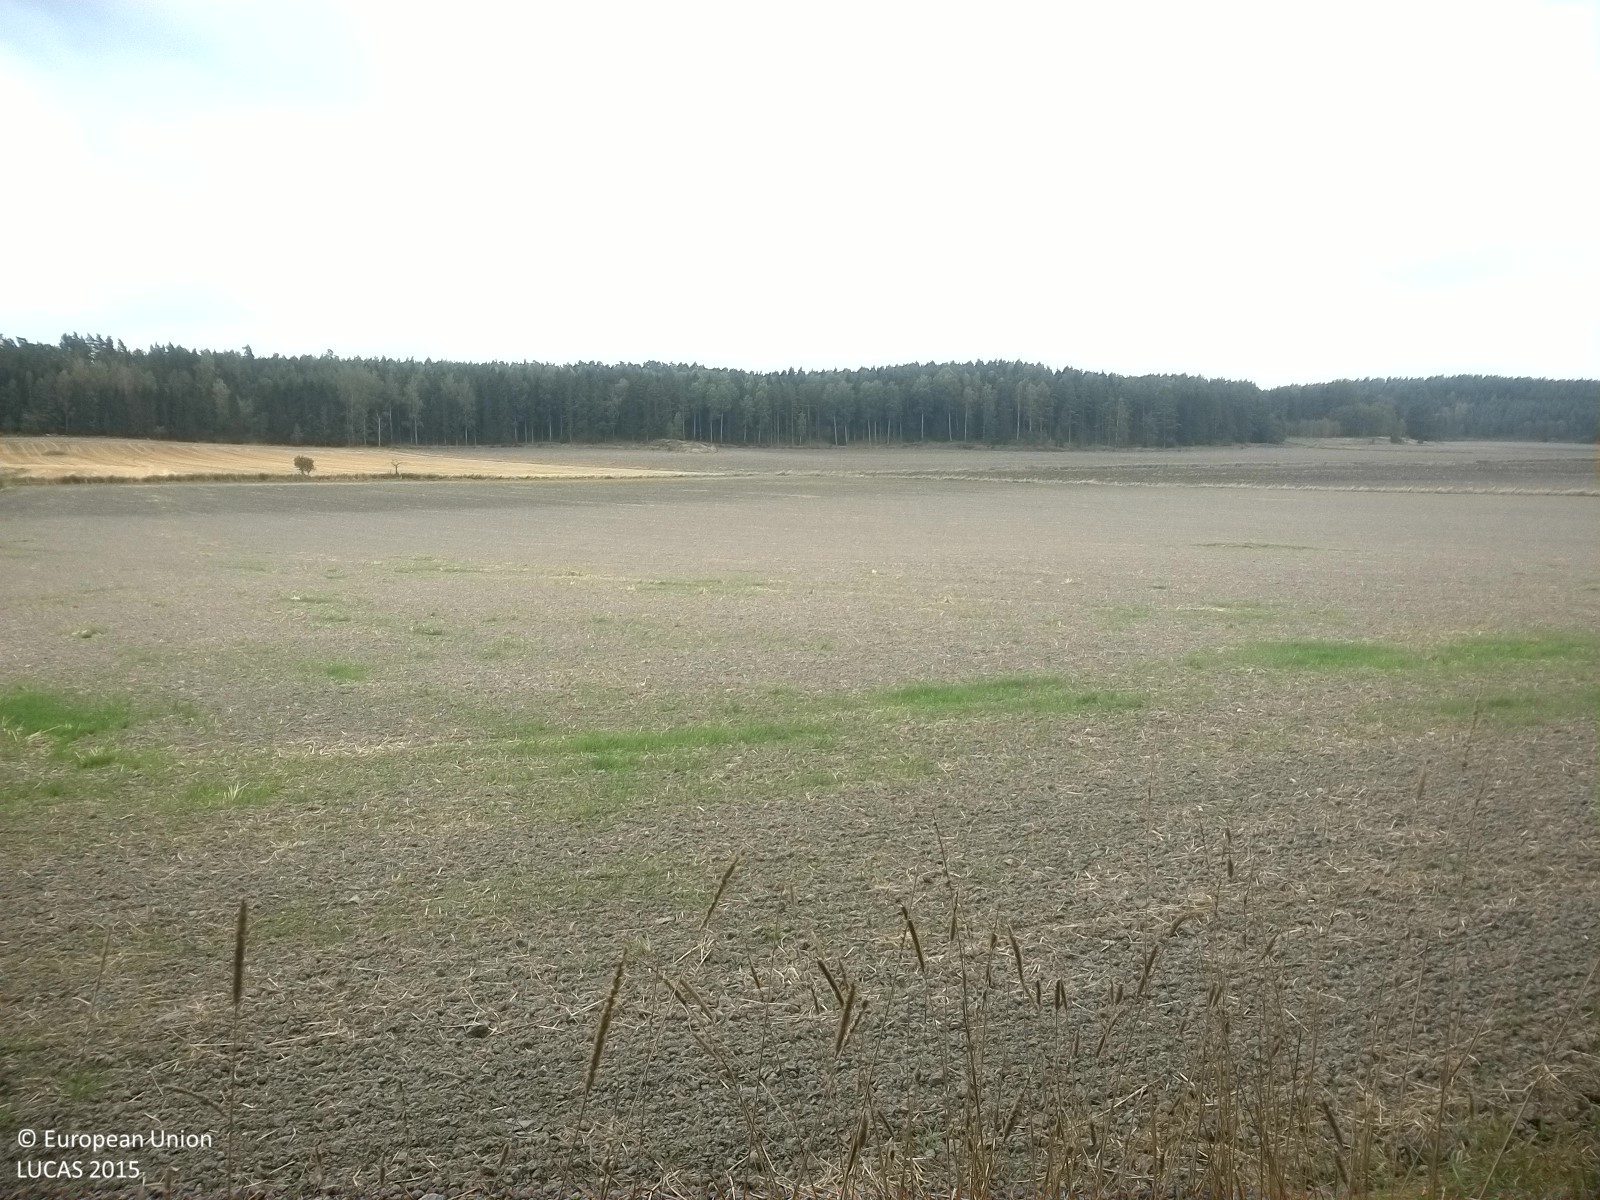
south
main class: Woodland
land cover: Pine dominated coniferous woodland
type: boreal forest
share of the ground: 25 - 50 %
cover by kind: herbaceous plants 50 %, coniferous forest trees 30 %, shrubs 10 %, lichens and mosses 5 %, unconsolidated bare surface 5 %
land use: Forestry
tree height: > 5 m
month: September
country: SE
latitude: 58.4923
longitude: 16.5668
